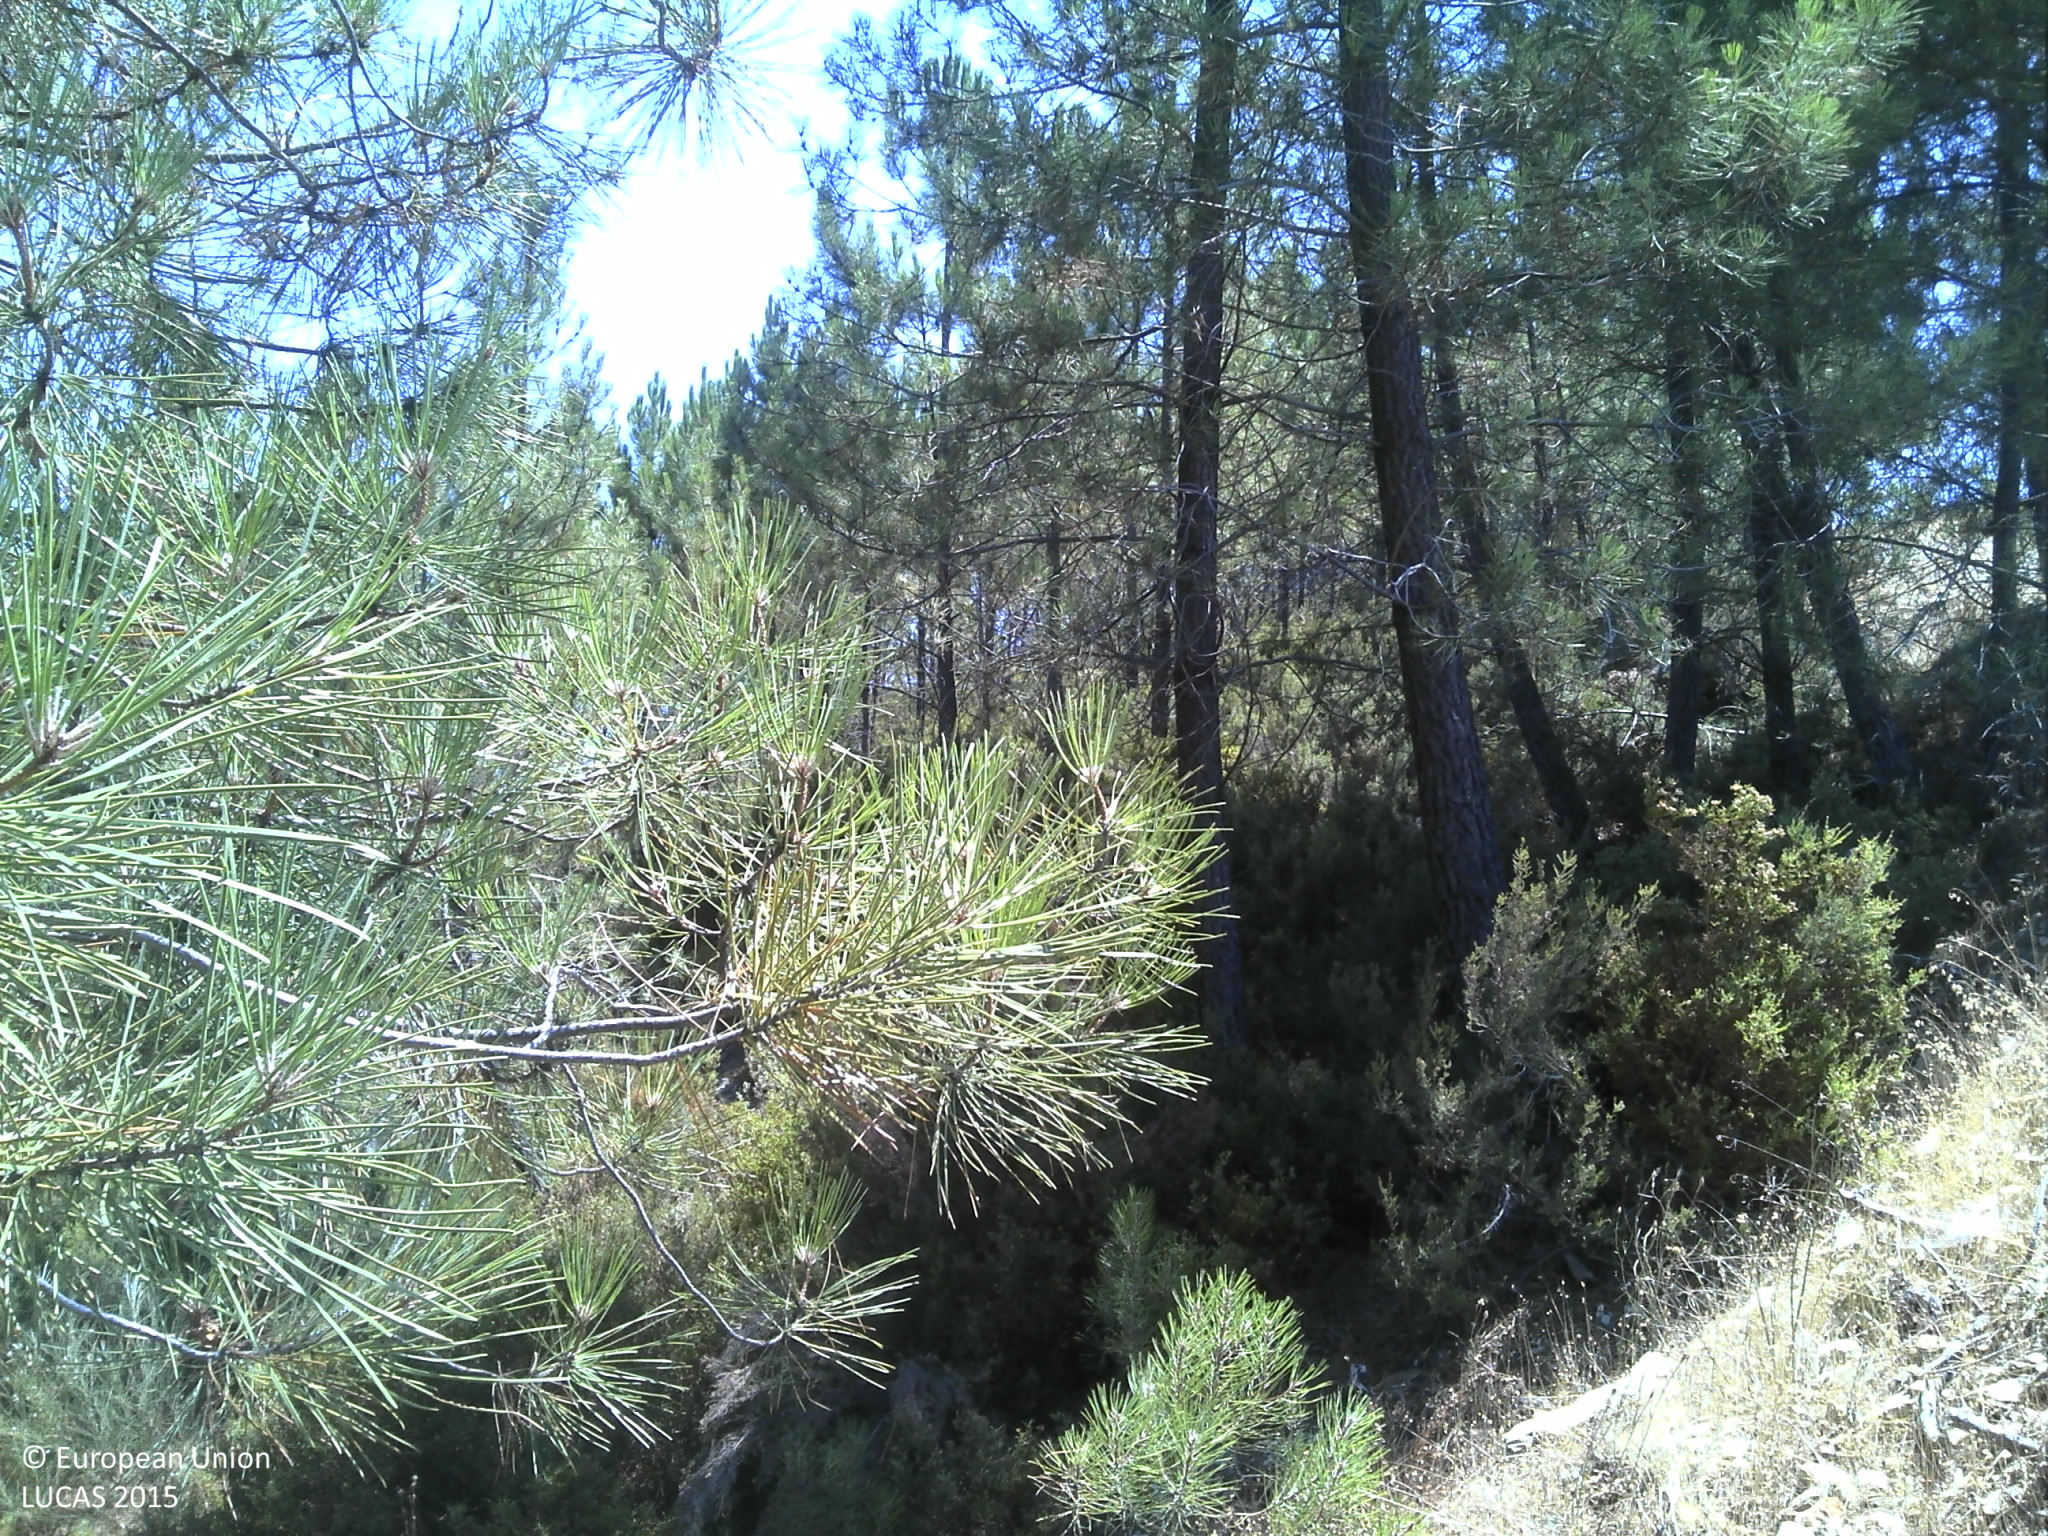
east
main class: Woodland
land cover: Pine dominated coniferous woodland
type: coniferous forest of the mediterranean region
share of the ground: 25 - 50 %
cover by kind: coniferous forest trees 45 %, unconsolidated bare surface 30 %, shrubs 25 %
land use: Forestry
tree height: > 5 m
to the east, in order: Pine dominated coniferous woodland; Tracks; Pine dominated coniferous woodland; Tracks; Pine dominated coniferous woodland; Other bare soil; Paved roads, cycling and walking lanes; Shrubland with sparse tree cover
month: July
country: PT
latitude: 40.1161
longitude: -7.6251
